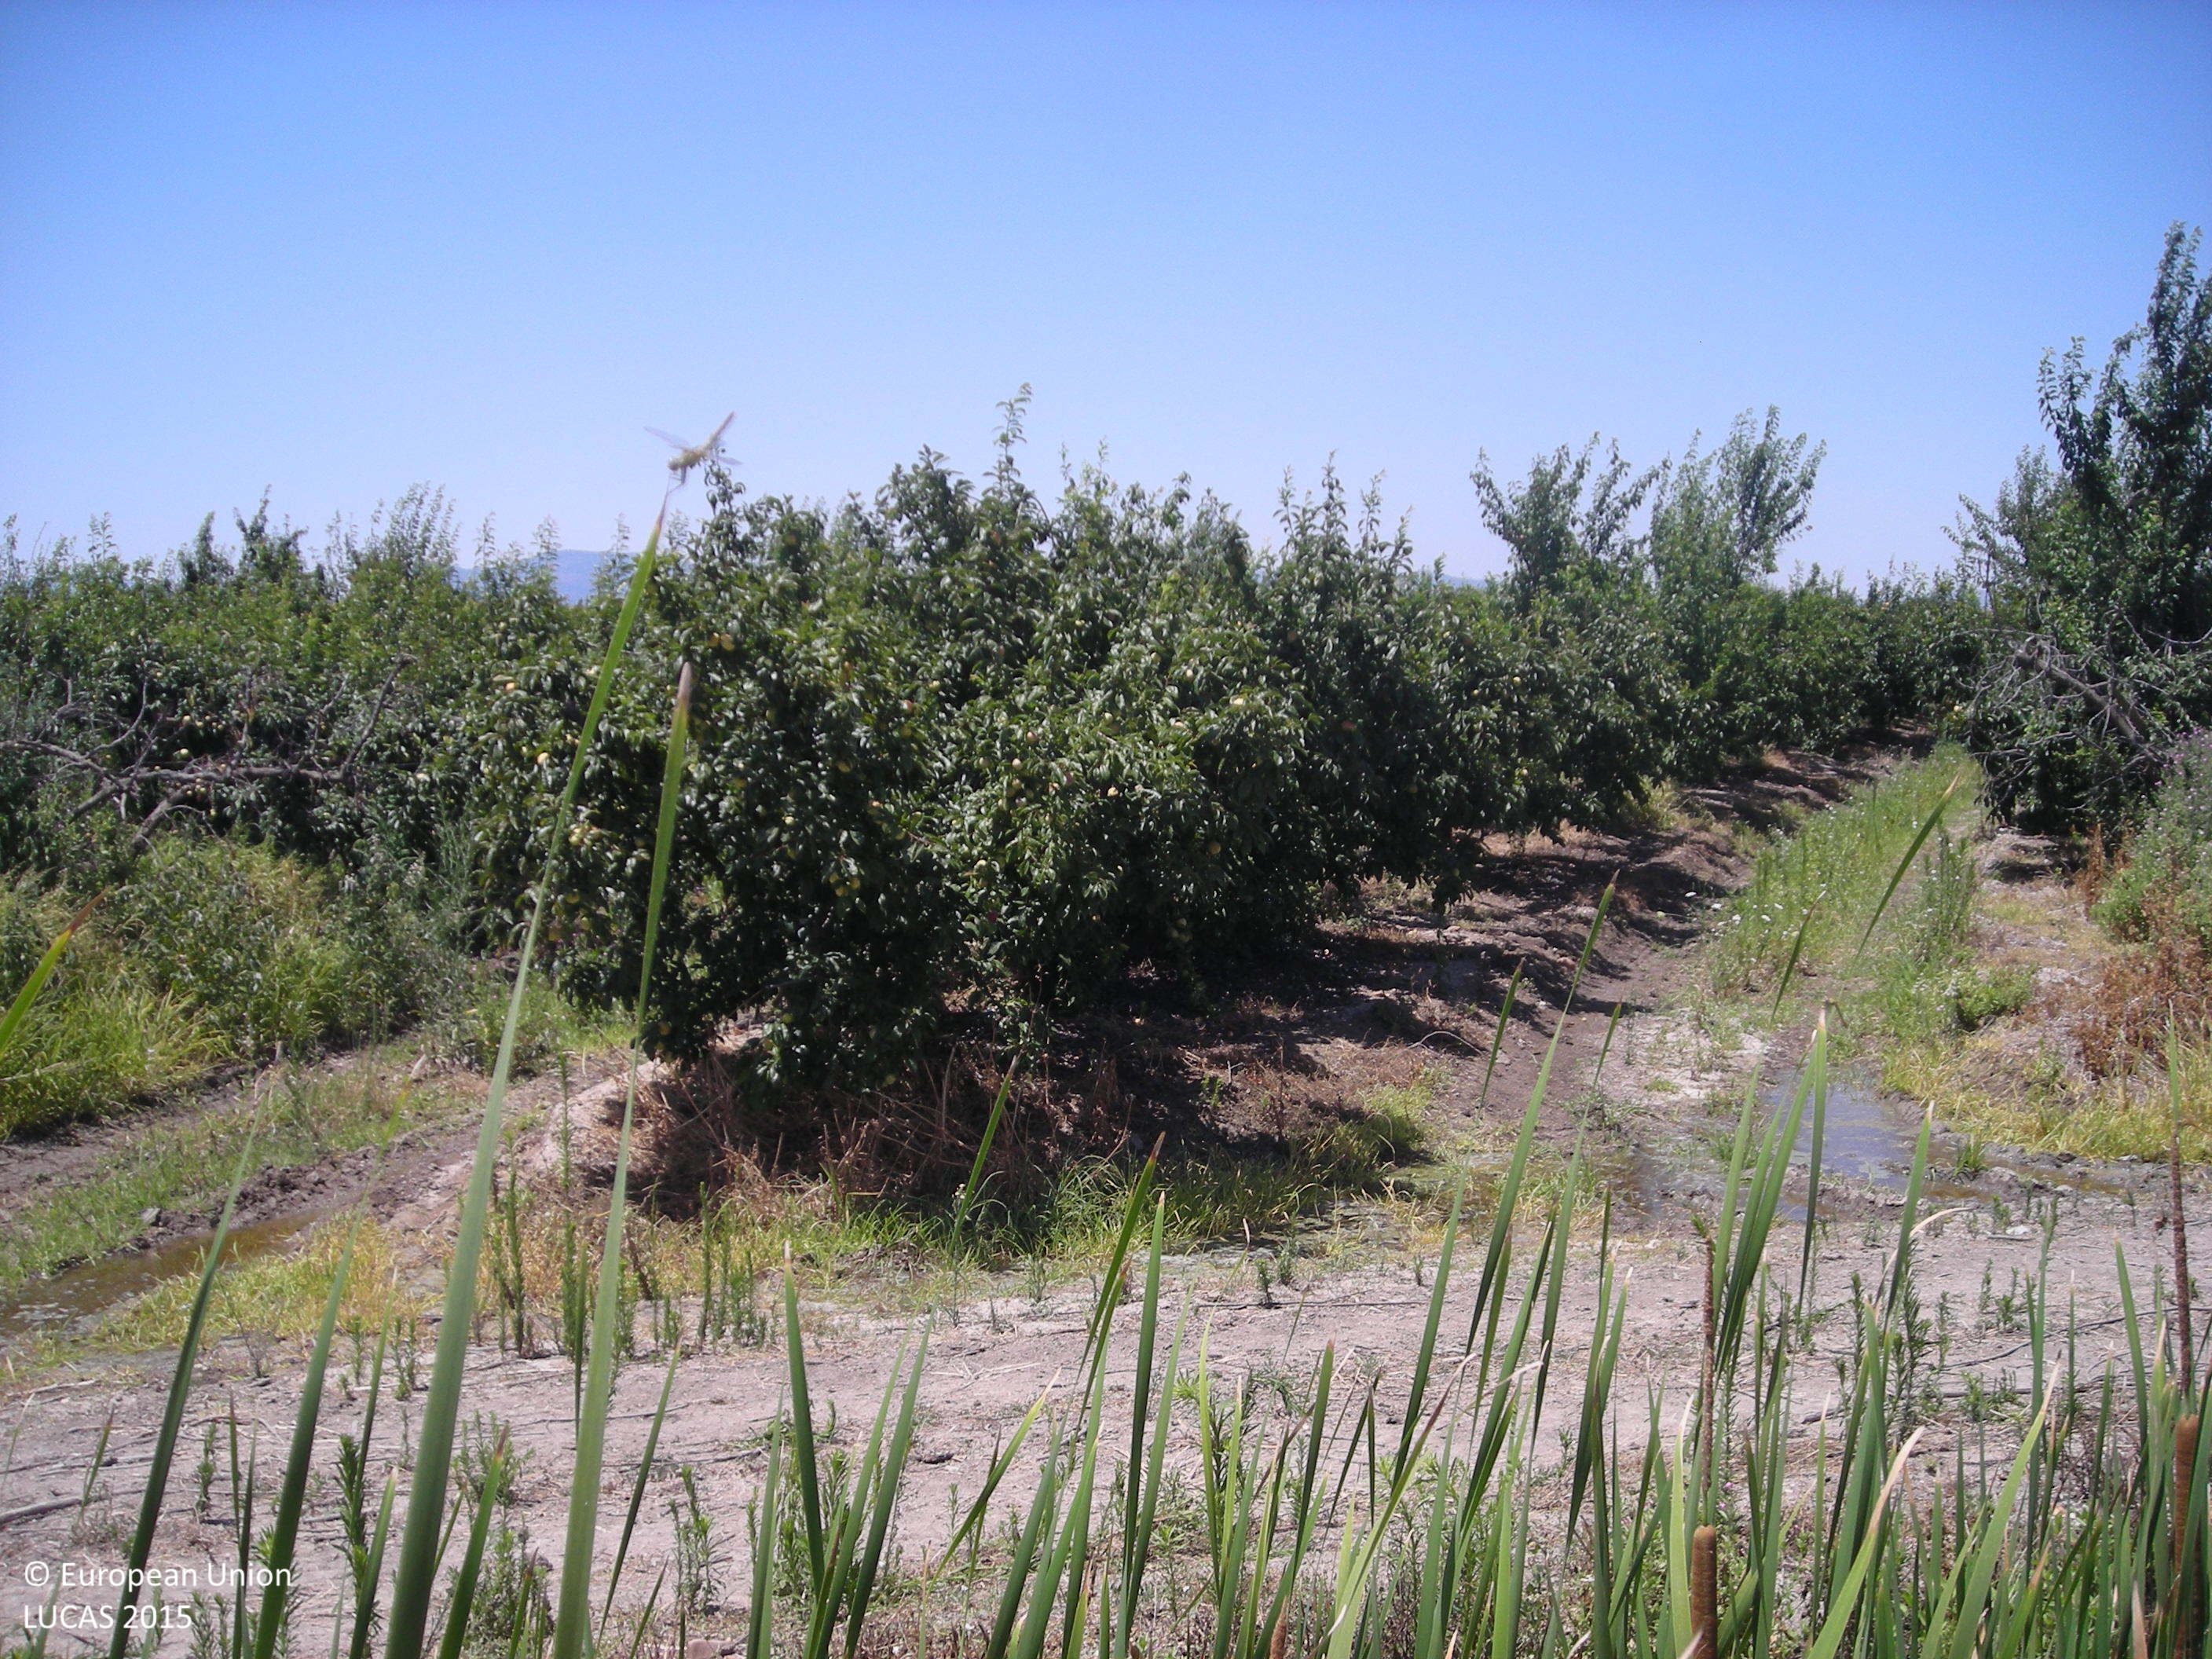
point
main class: Cropland
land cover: Other fruit trees and berries
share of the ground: > 75 %
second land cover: Other bare soil
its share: > 75 %
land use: Agriculture (excluding fallow land and kitchen gardens)
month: July
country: ES
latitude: 39.0972
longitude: -5.8576
